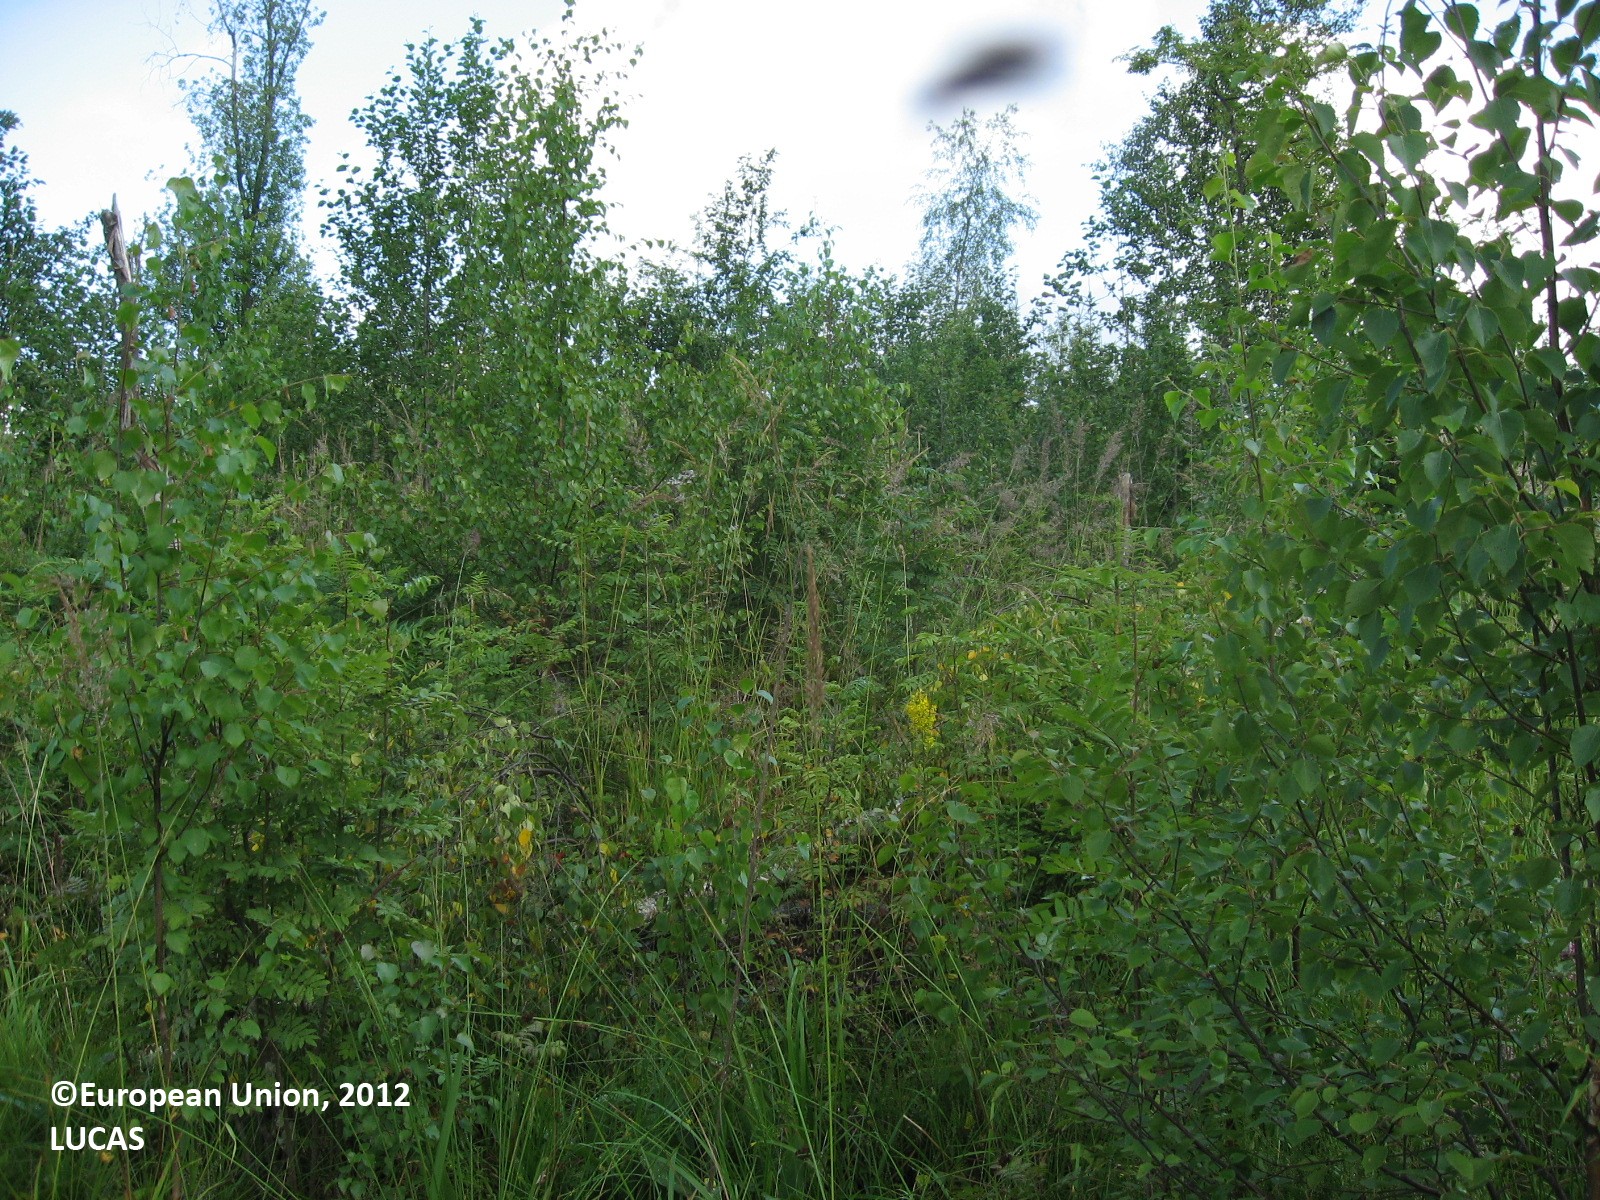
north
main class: Woodland
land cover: Broadleaved woodland
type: boreal forest
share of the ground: 25 - 50 %
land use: Forestry
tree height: < 5 m
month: July
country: FI
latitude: 61.3185
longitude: 25.8778
